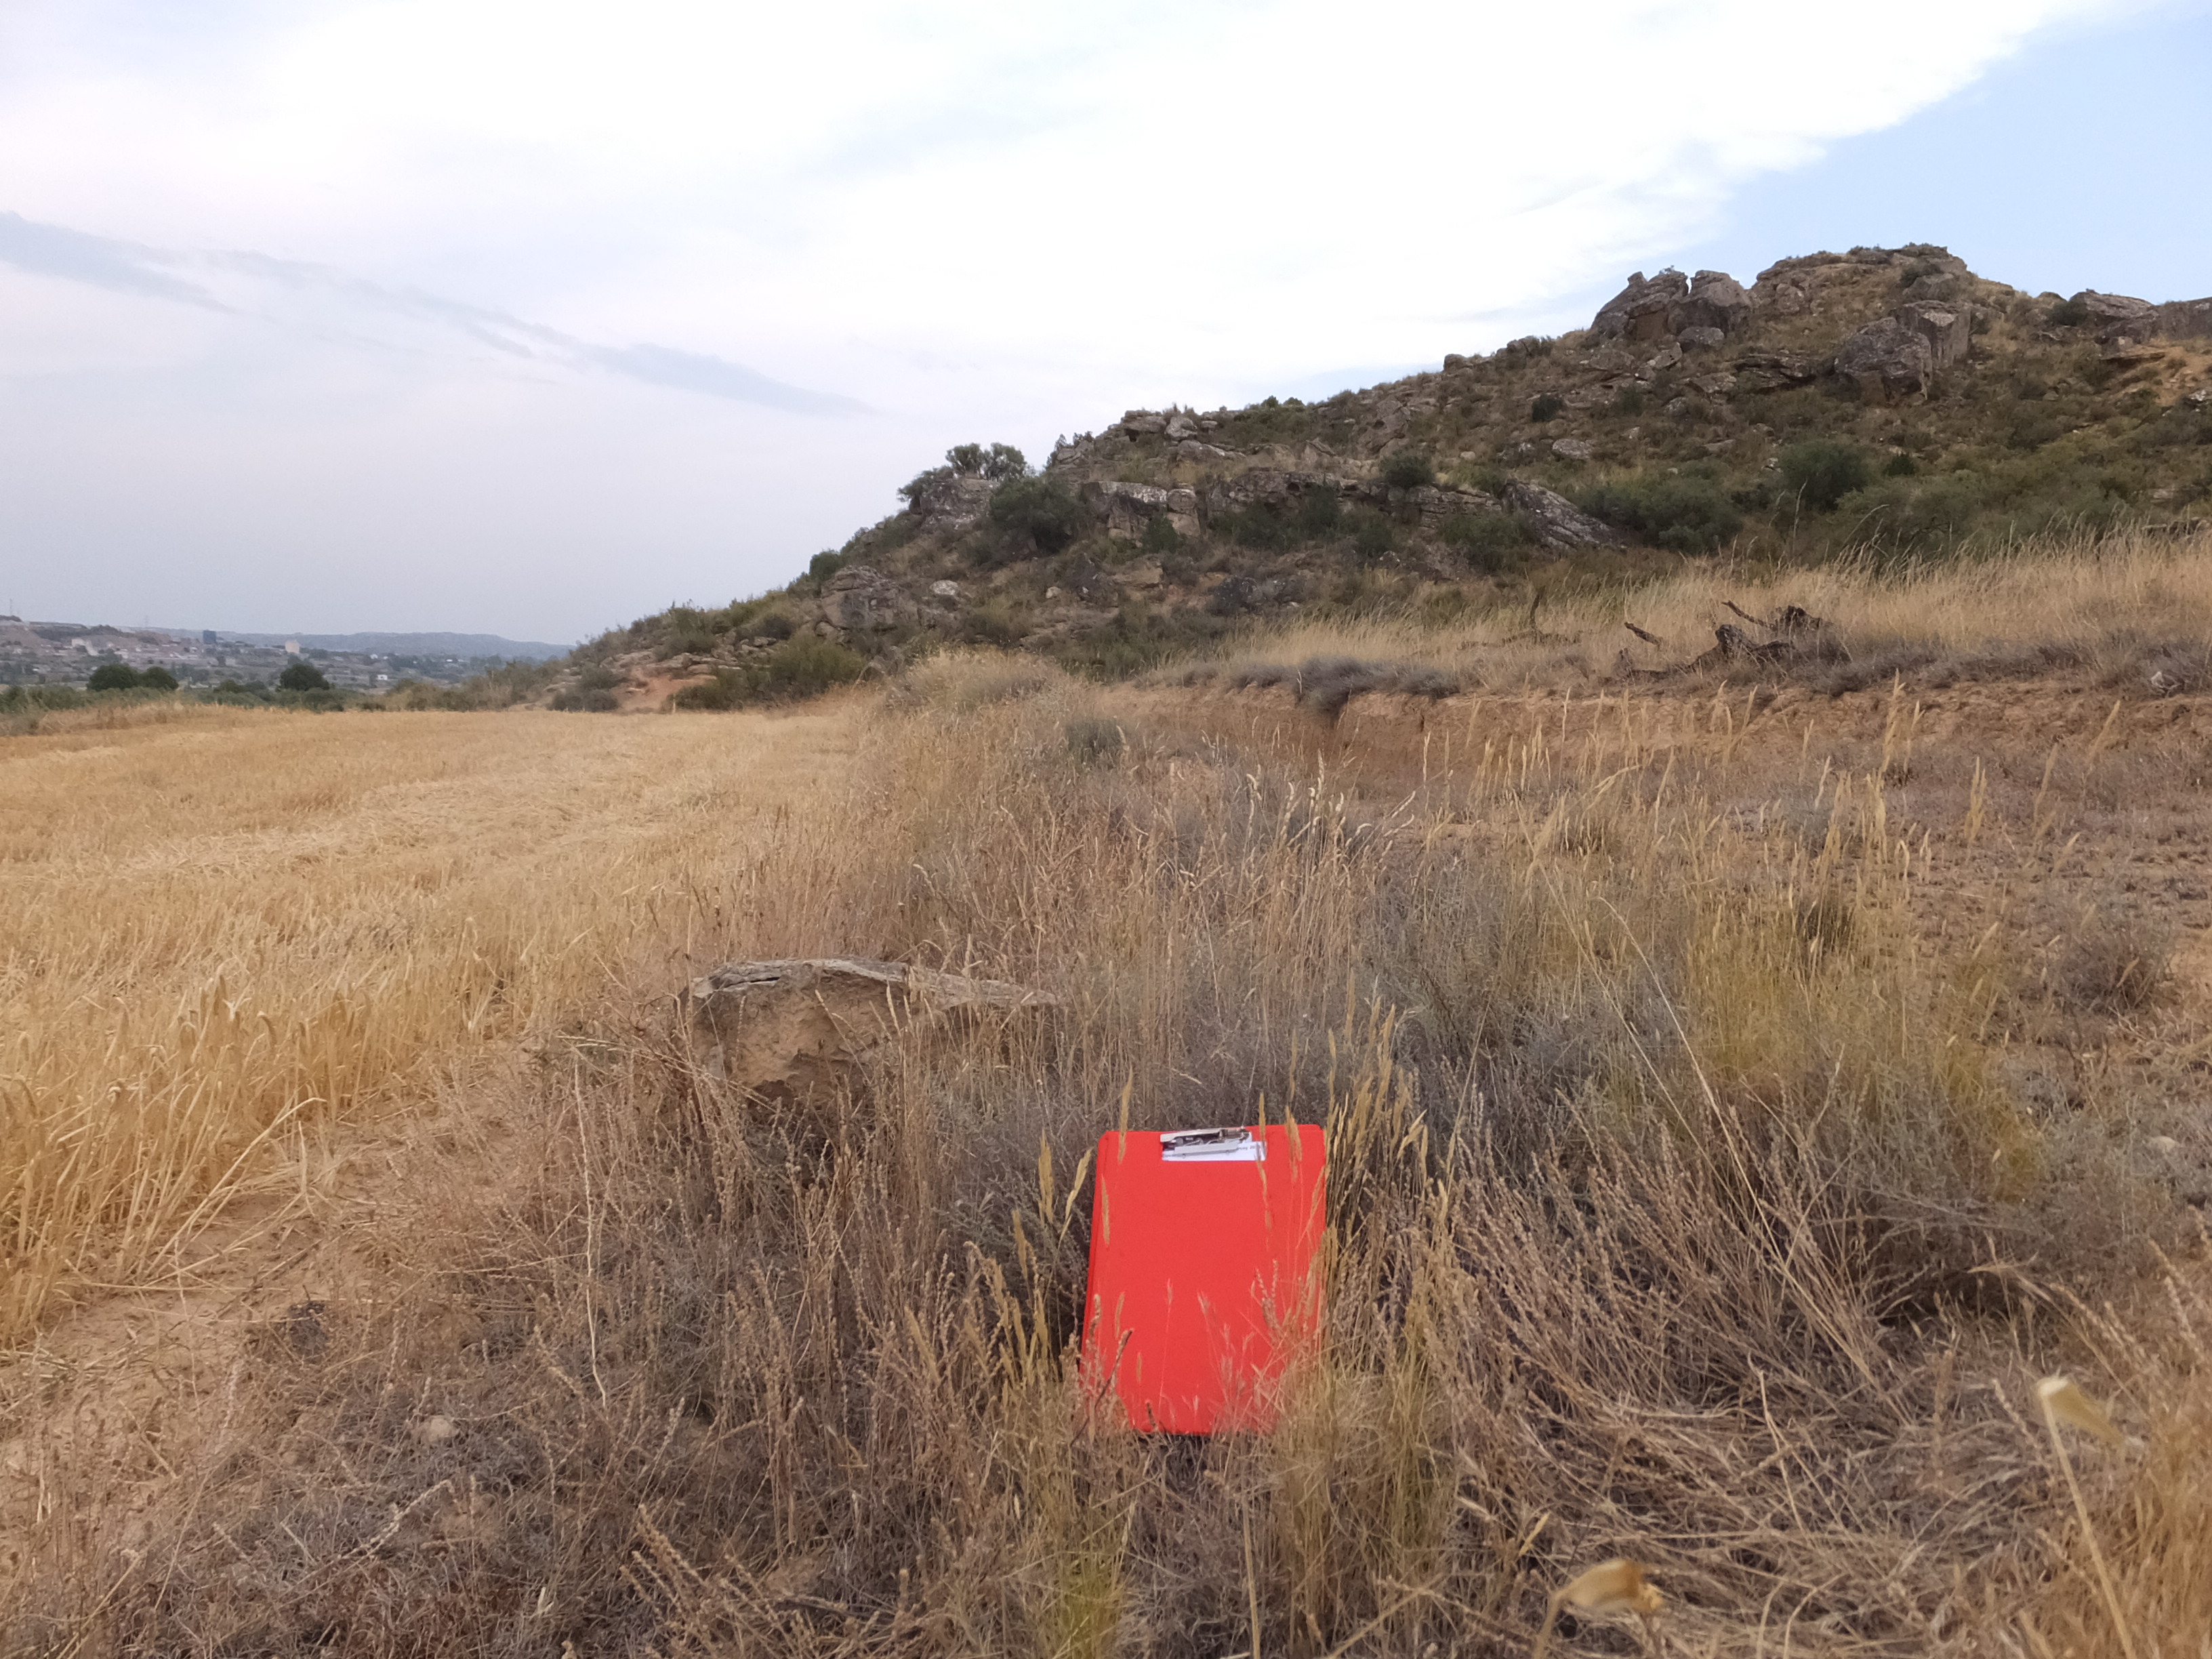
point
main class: Grassland
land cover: Grassland without tree/shrub cover
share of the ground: > 75 %
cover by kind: herbaceous plants 95 %, shrubs 5 %
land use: Semi-natural and natural areas not in use
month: July
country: ES
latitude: 41.2232
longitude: -0.0686
